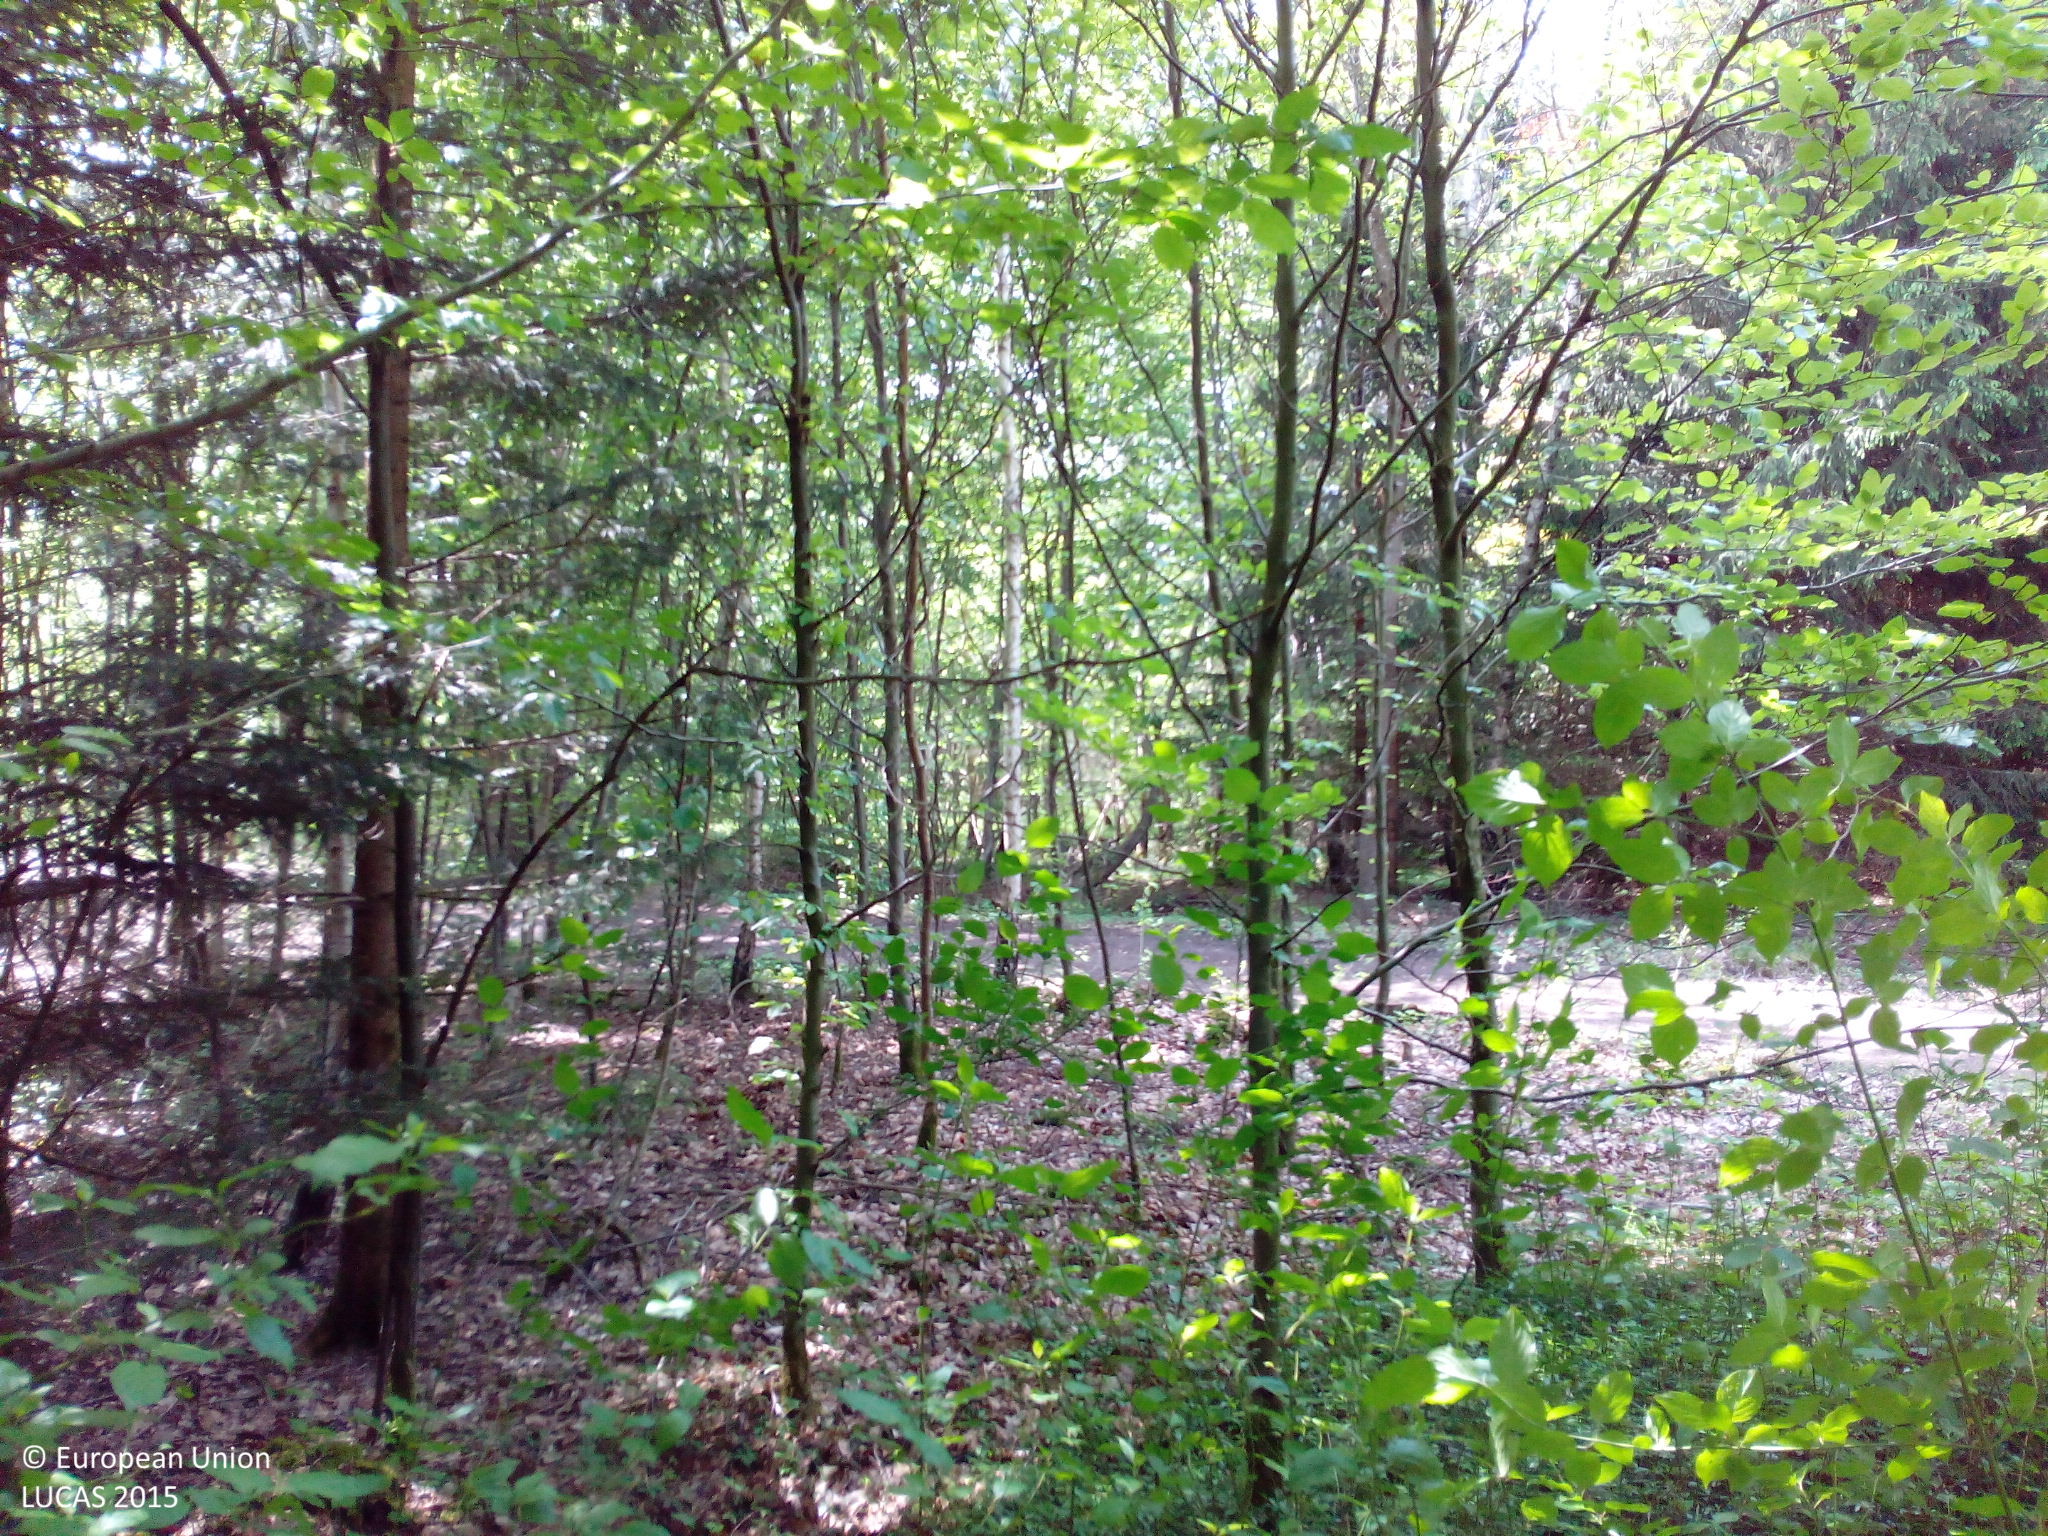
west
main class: Woodland
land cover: Broadleaved woodland
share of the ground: > 75 %
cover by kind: broadleaved forest trees 75 %, coniferous forest trees 25 %
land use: Forestry
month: May
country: DE
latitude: 48.1245
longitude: 11.4098
